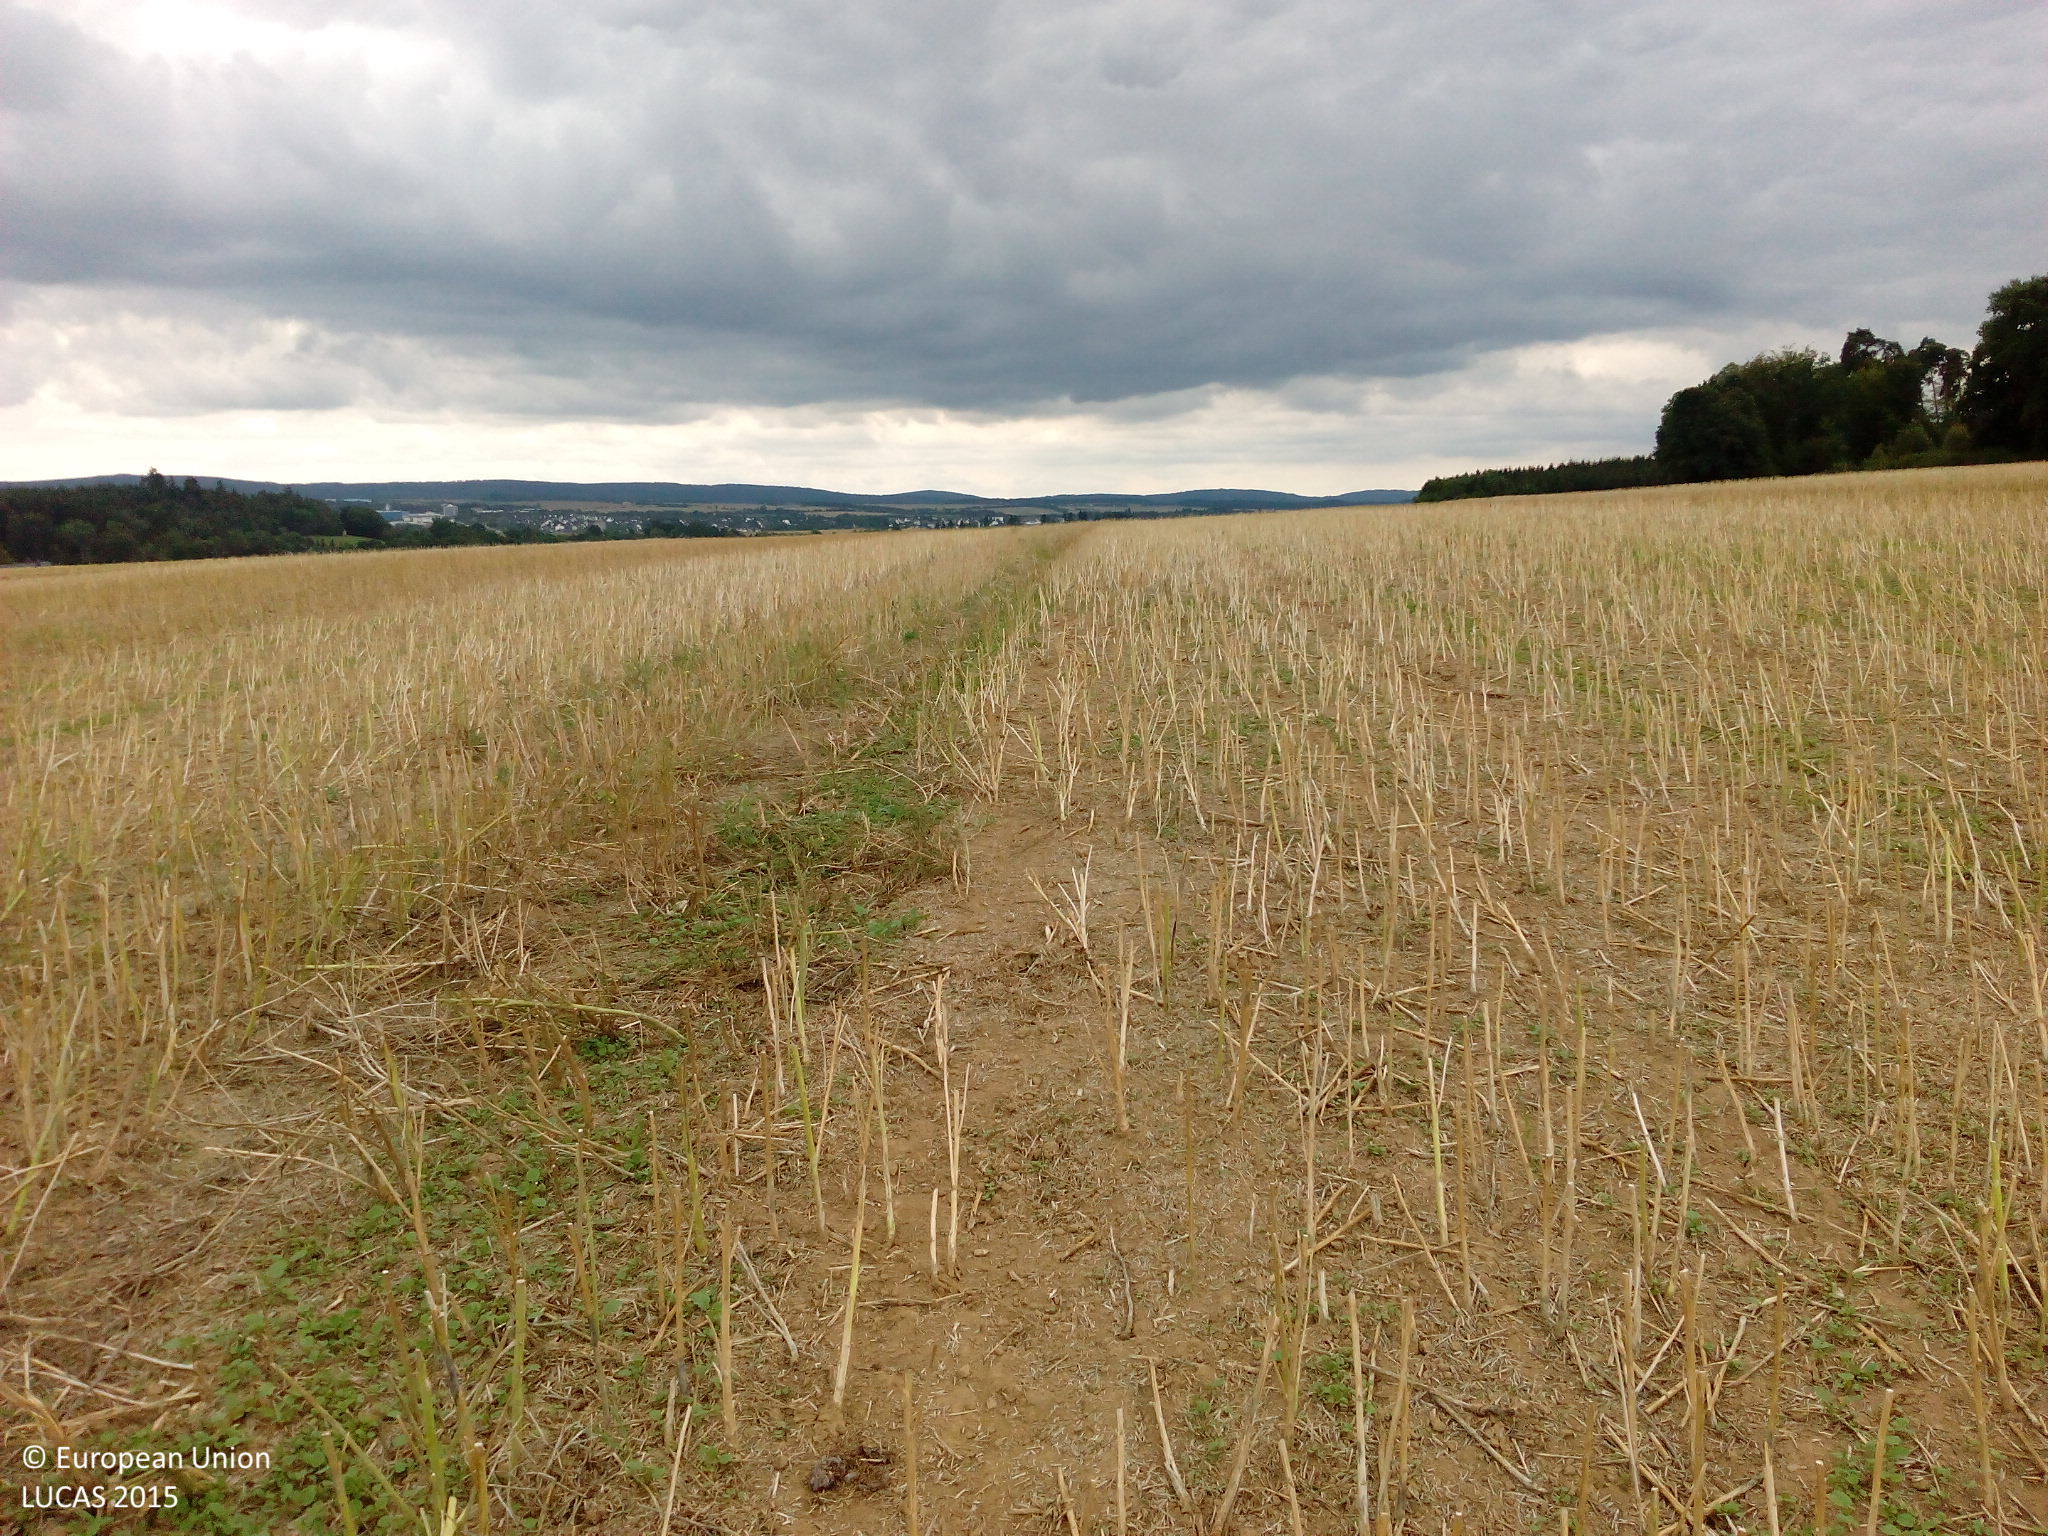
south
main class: Cropland
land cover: Rape and turnip rape
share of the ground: < 10 %
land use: Agriculture (excluding fallow land and kitchen gardens)
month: August
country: DE
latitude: 50.0136
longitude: 7.5303
